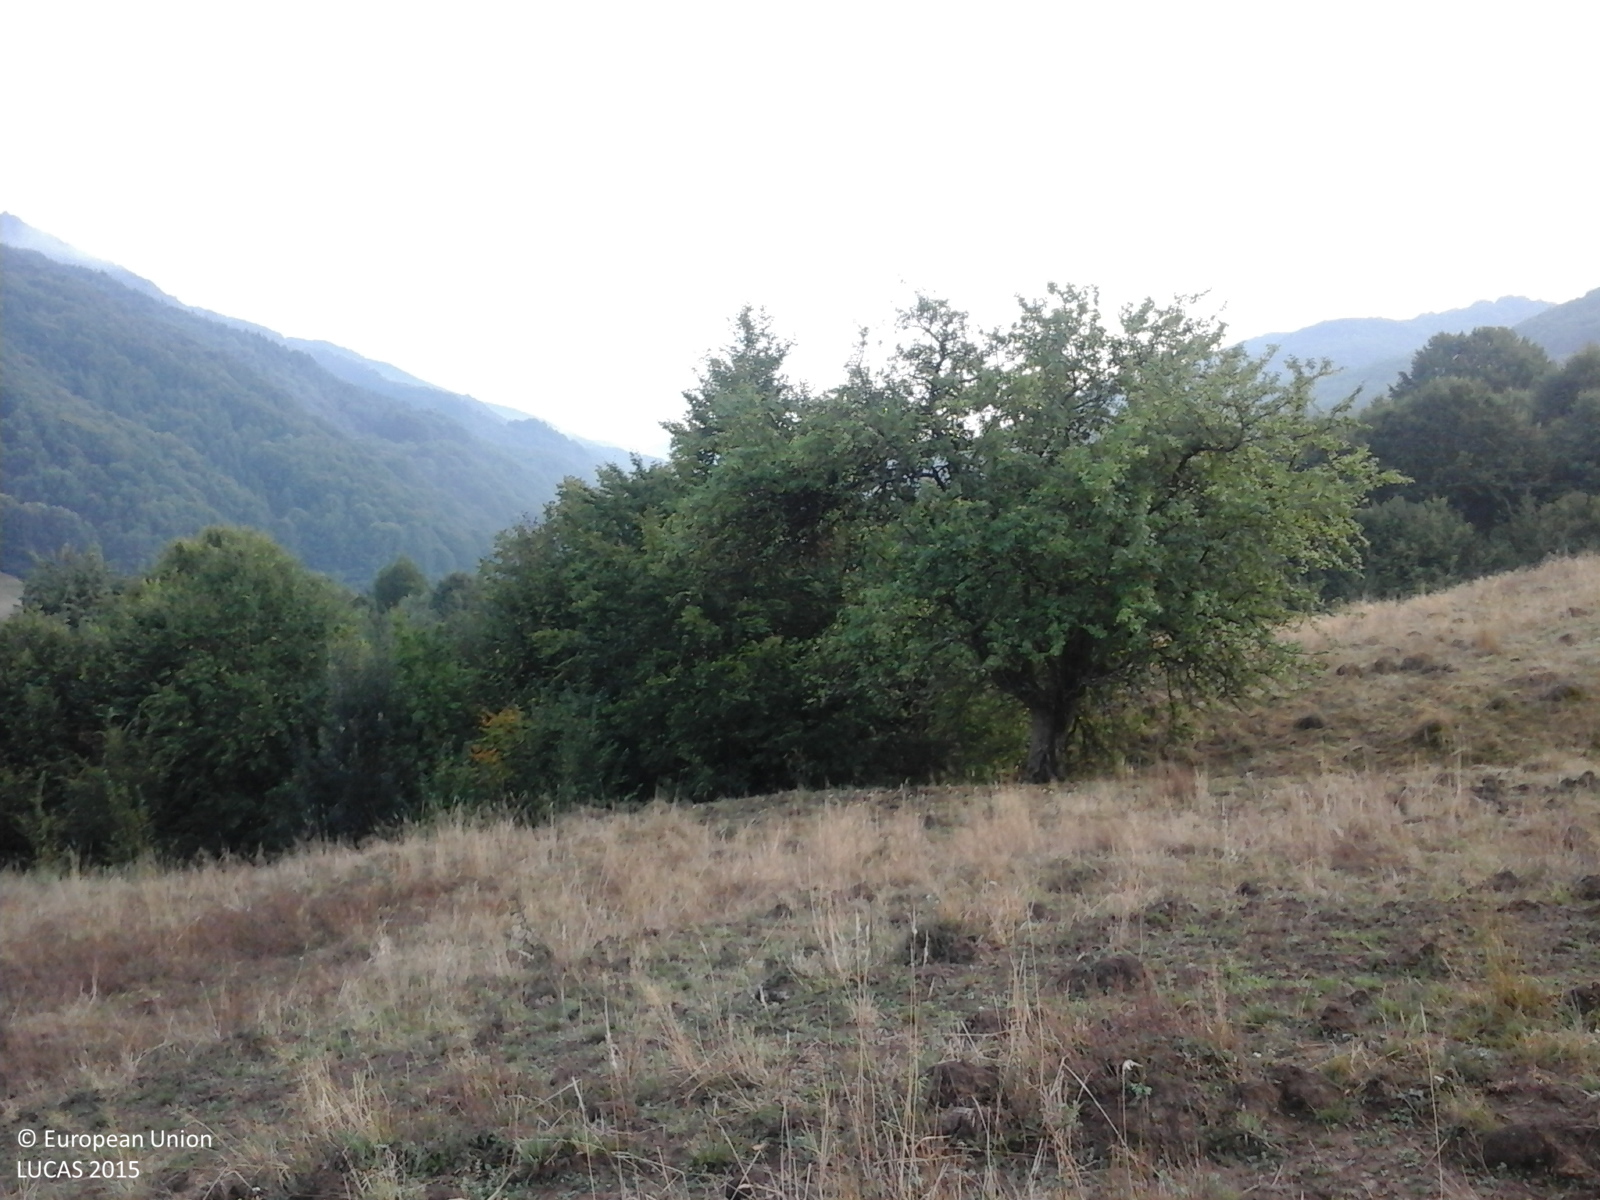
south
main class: Grassland
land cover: Grassland without tree/shrub cover
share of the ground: > 75 %
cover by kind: herbaceous plants 100 %
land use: Agriculture (excluding fallow land and kitchen gardens)
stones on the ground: < 10 %
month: September
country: RO
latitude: 47.5730
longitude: 24.0564
